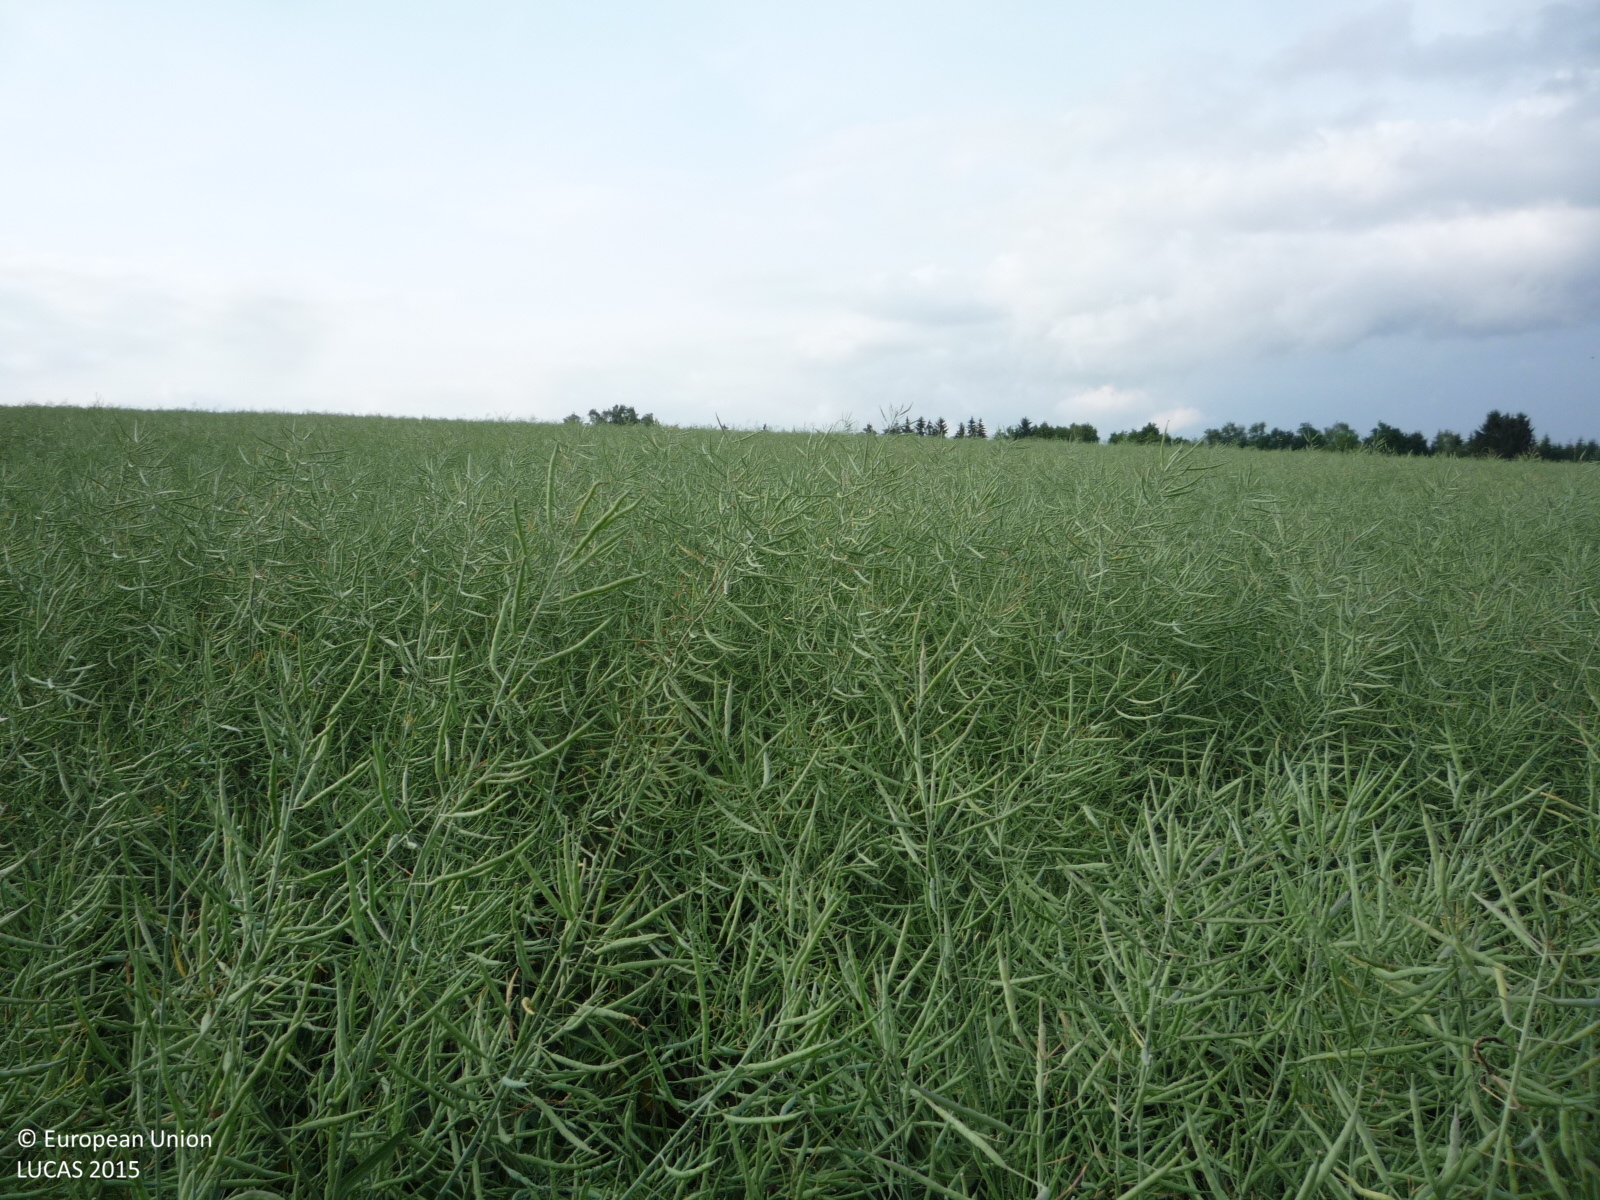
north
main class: Cropland
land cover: Rape and turnip rape
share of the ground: > 75 %
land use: Agriculture (excluding fallow land and kitchen gardens)
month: June
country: CZ
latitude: 49.6909
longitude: 15.1180
